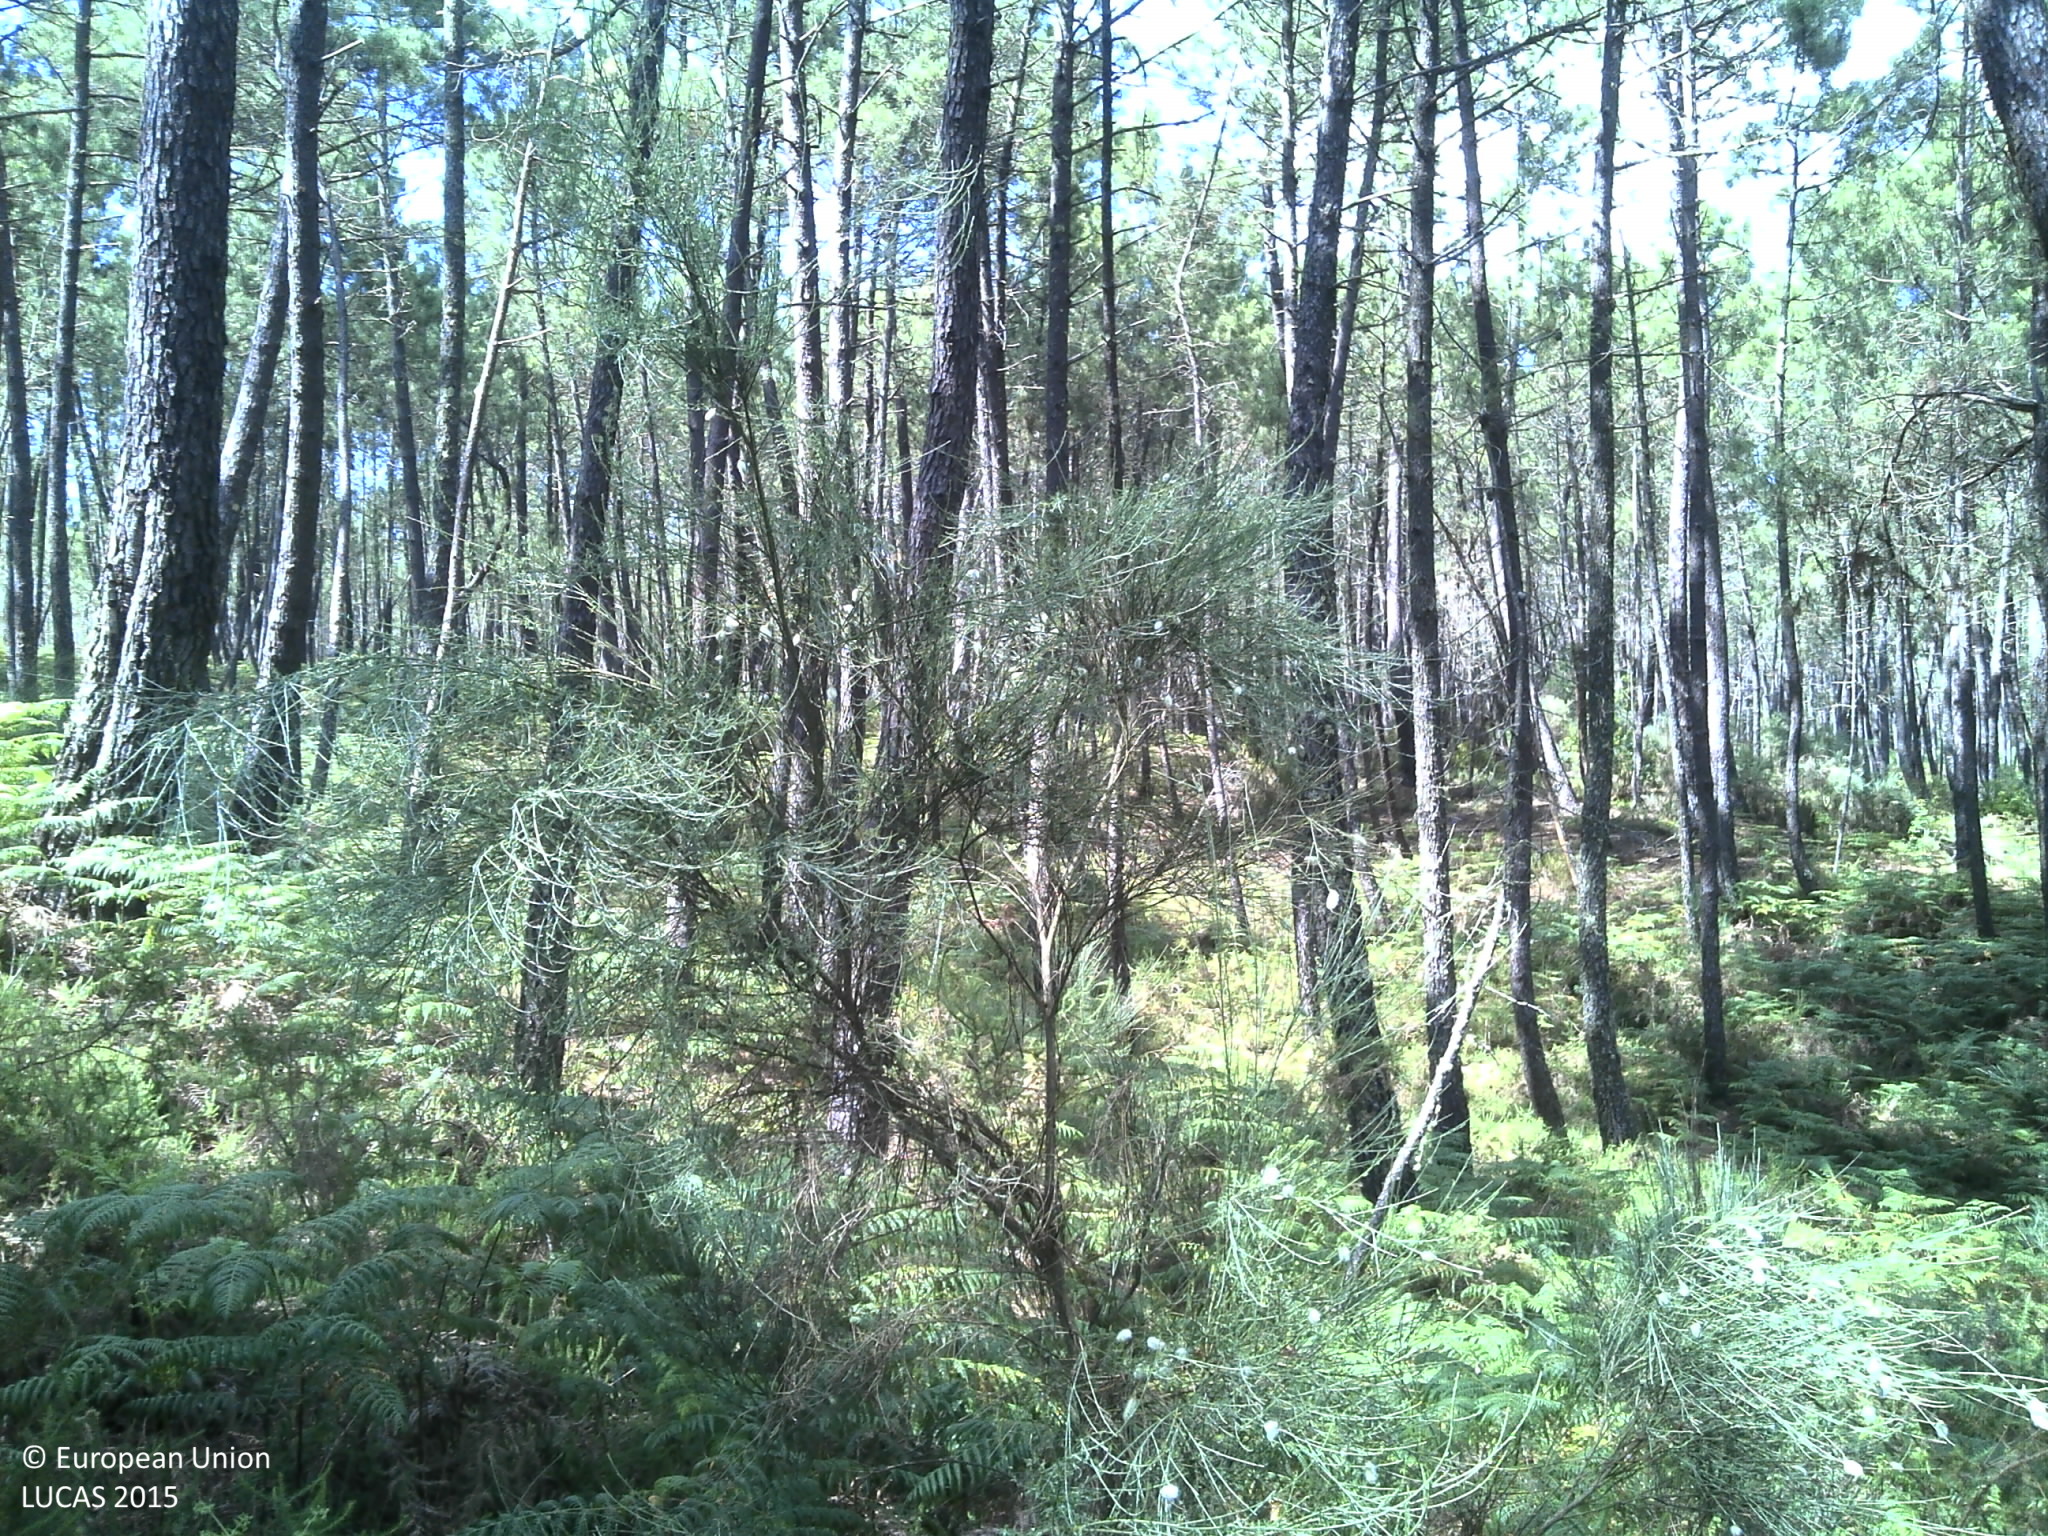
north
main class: Woodland
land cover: Pine dominated coniferous woodland
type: coniferous forest of the mediterranean region
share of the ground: 50 - 75 %
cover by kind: coniferous forest trees 60 %, shrubs 25 %, unconsolidated bare surface 15 %
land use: Forestry
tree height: > 5 m
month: June
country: PT
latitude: 40.8404
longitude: -8.0029
